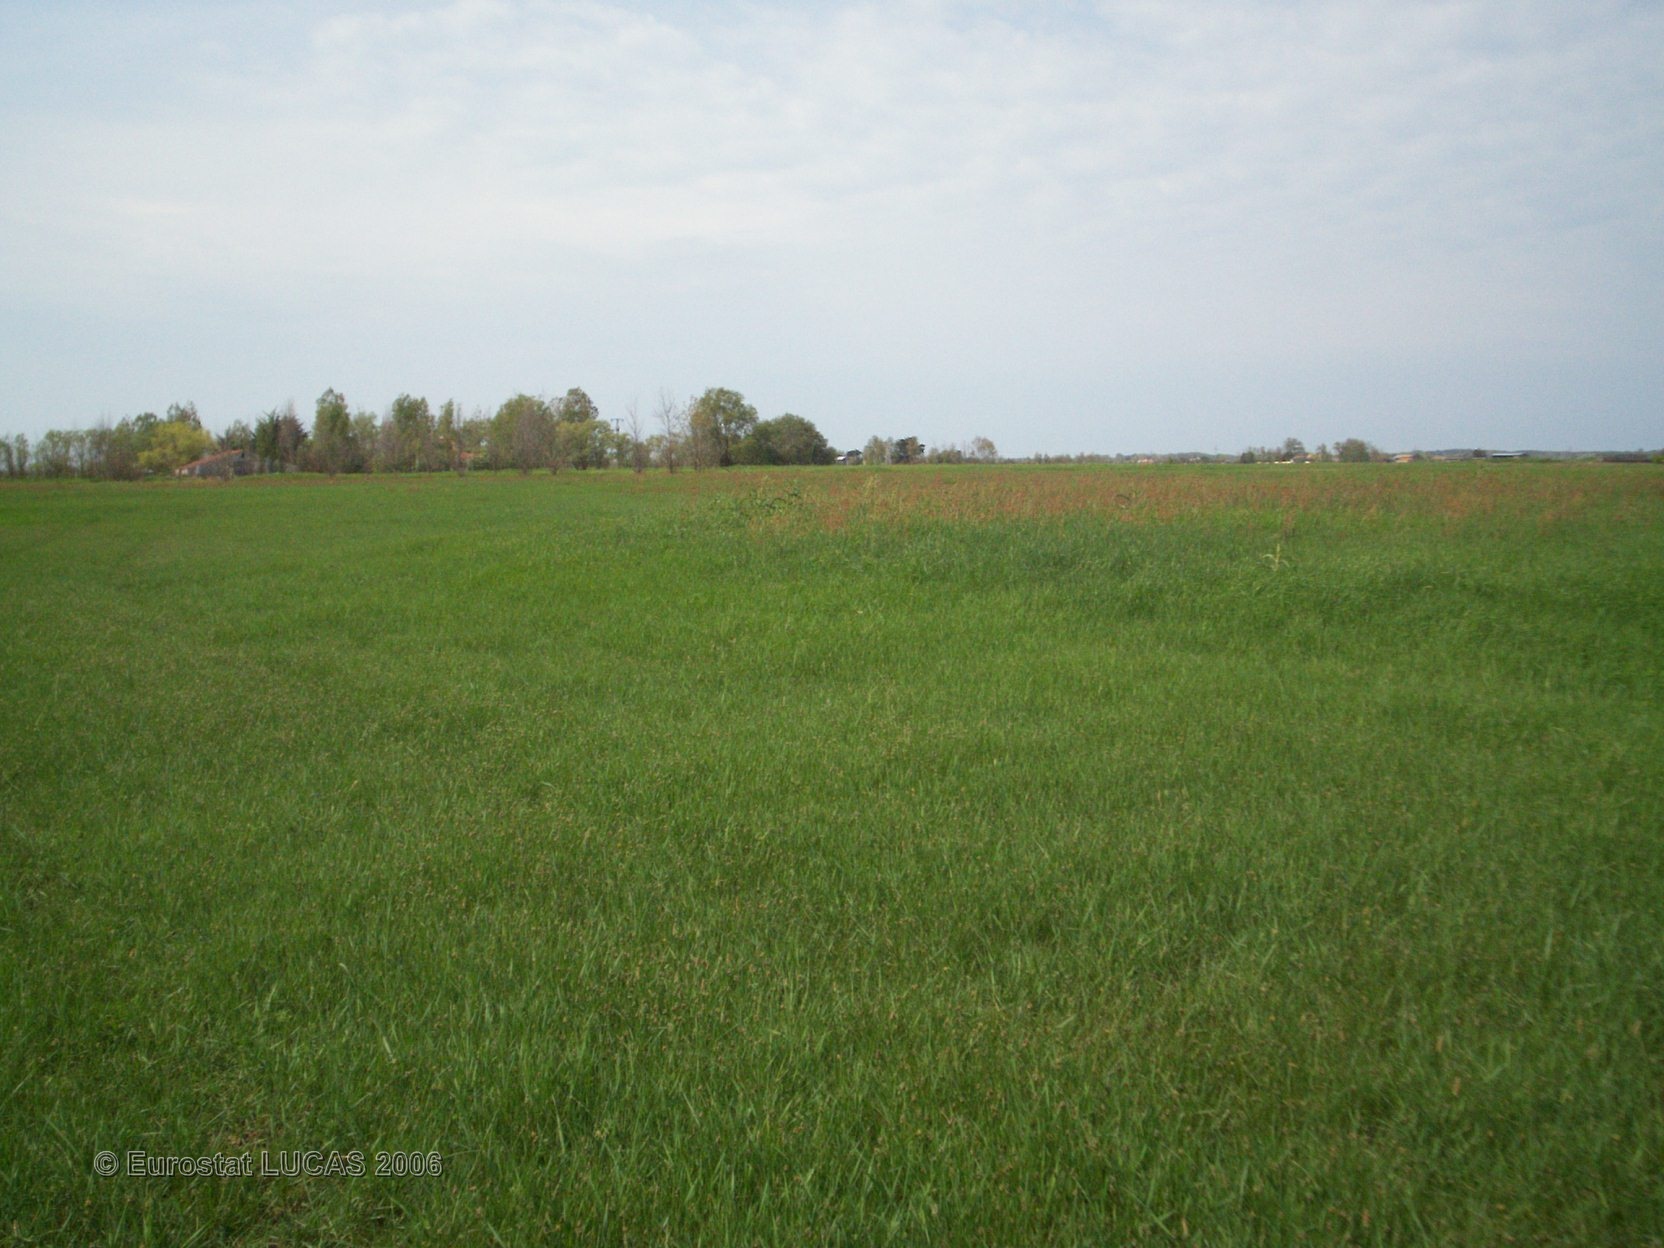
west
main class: Grassland
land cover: Grassland without tree/shrub cover
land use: Agriculture (excluding fallow land and kitchen gardens)
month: May
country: FR
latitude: 46.8476
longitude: -2.0727
